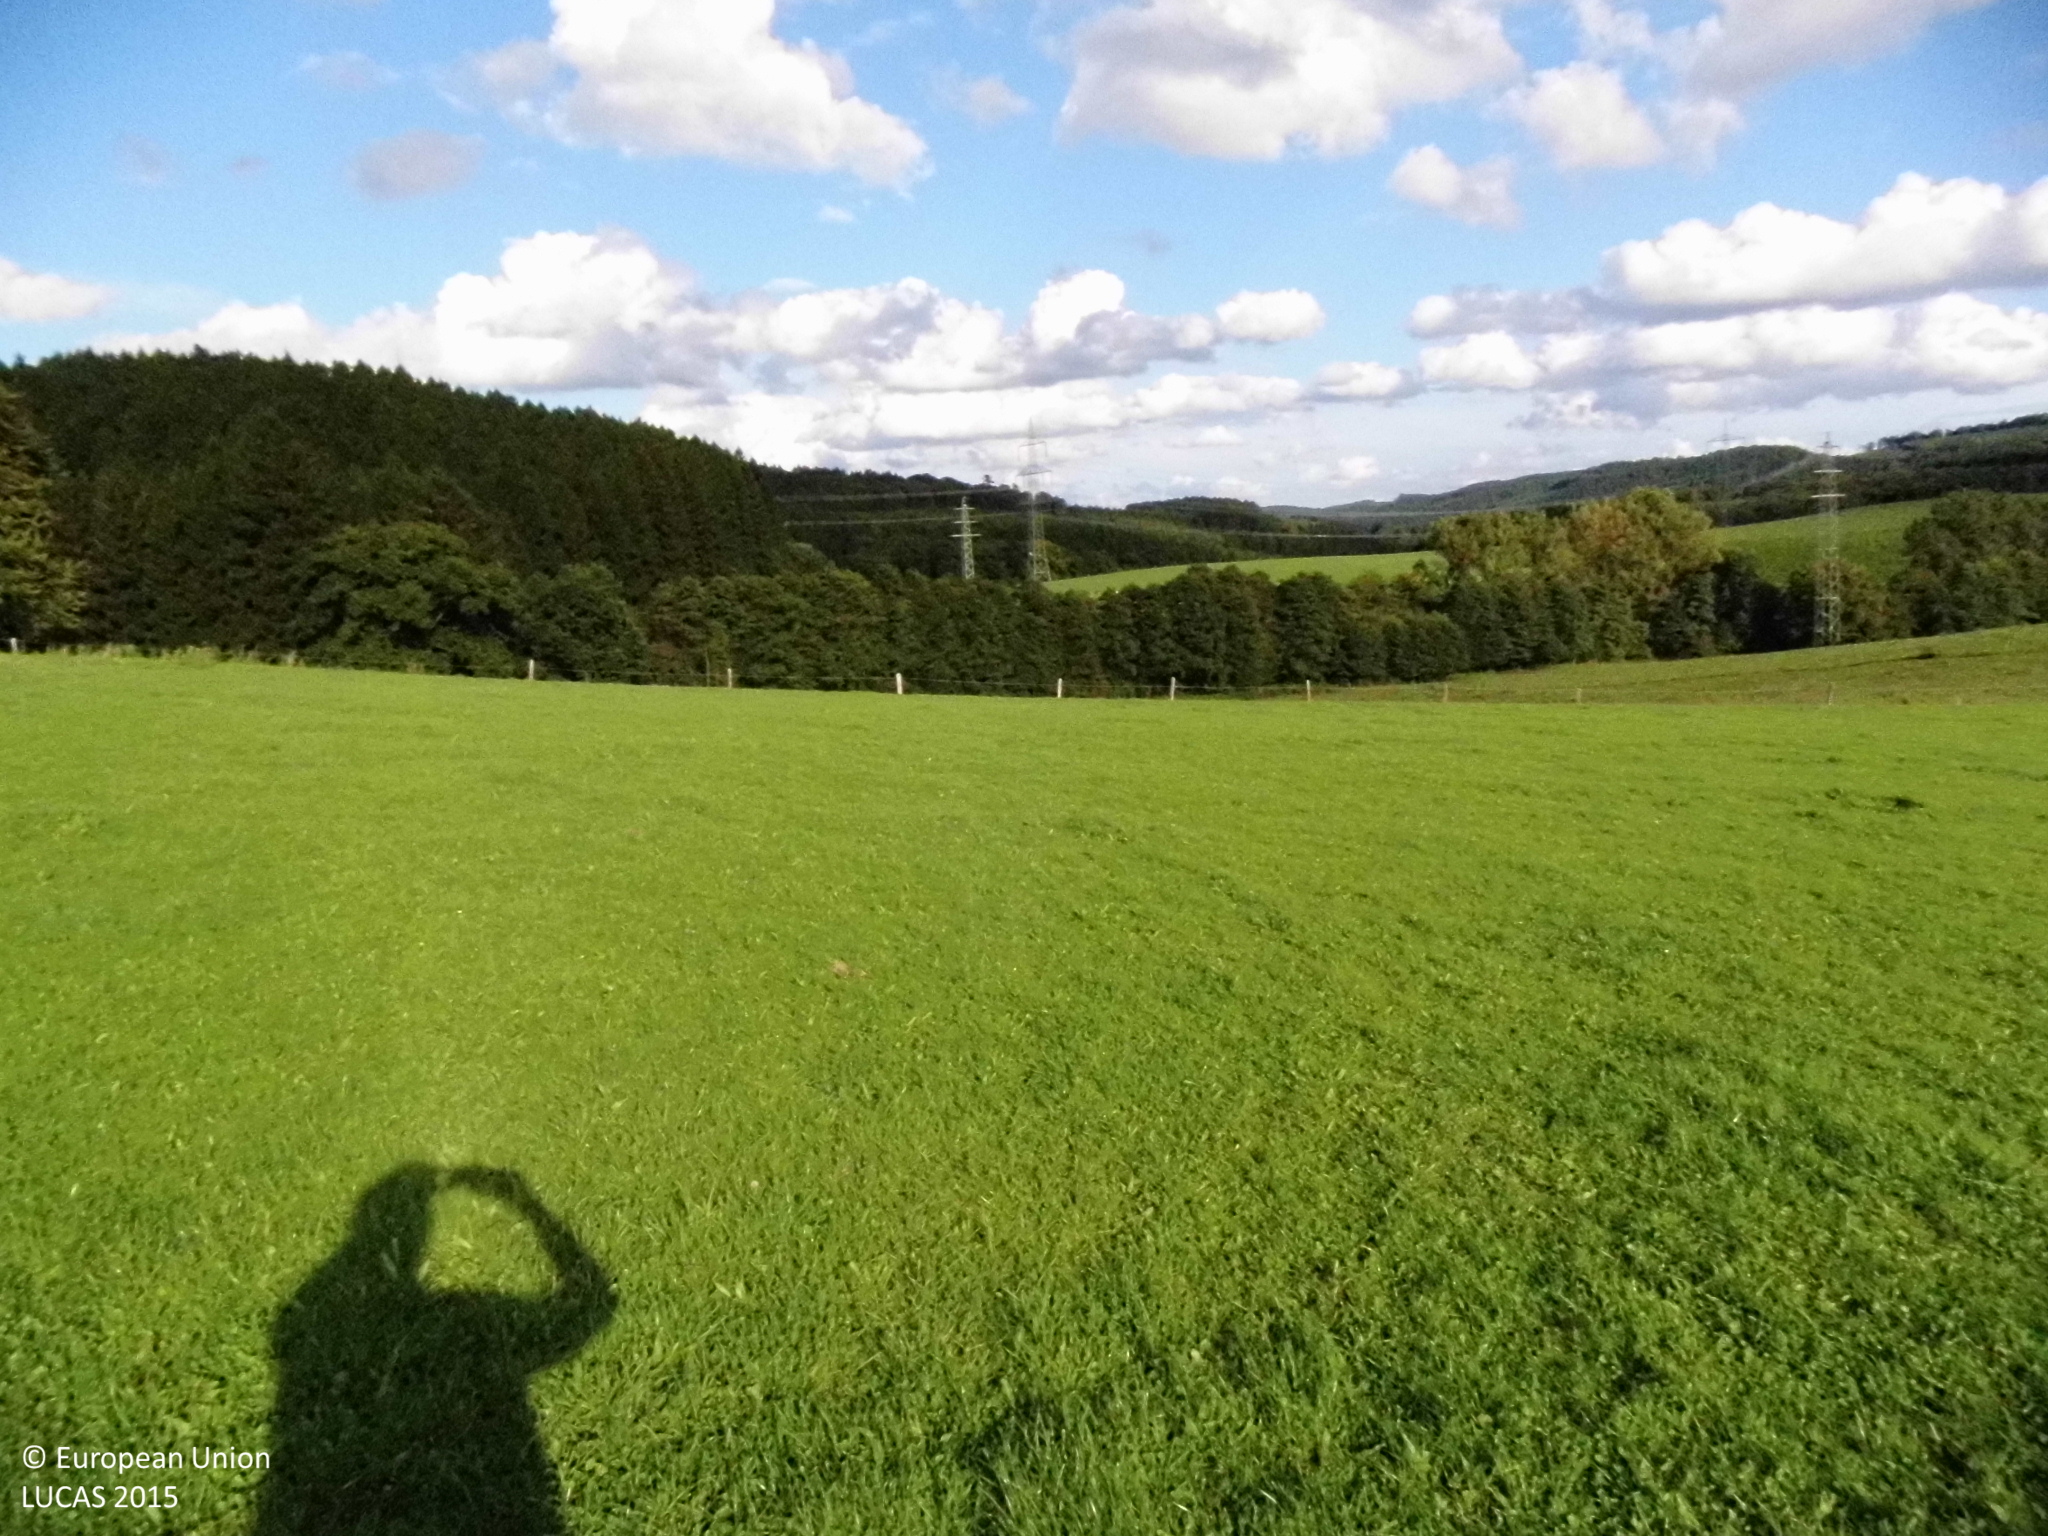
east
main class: Grassland
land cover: Grassland without tree/shrub cover
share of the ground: > 75 %
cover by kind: herbaceous plants 100 %
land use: Agriculture (excluding fallow land and kitchen gardens)
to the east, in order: Grassland without tree/shrub cover; Fences; Grassland without tree/shrub cover; Fences; Shrubland without tree cover; Inland fresh running water; Broadleaved woodland; Fences; Grassland without tree/shrub cover
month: September
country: DE
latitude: 51.0551
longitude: 7.4465
